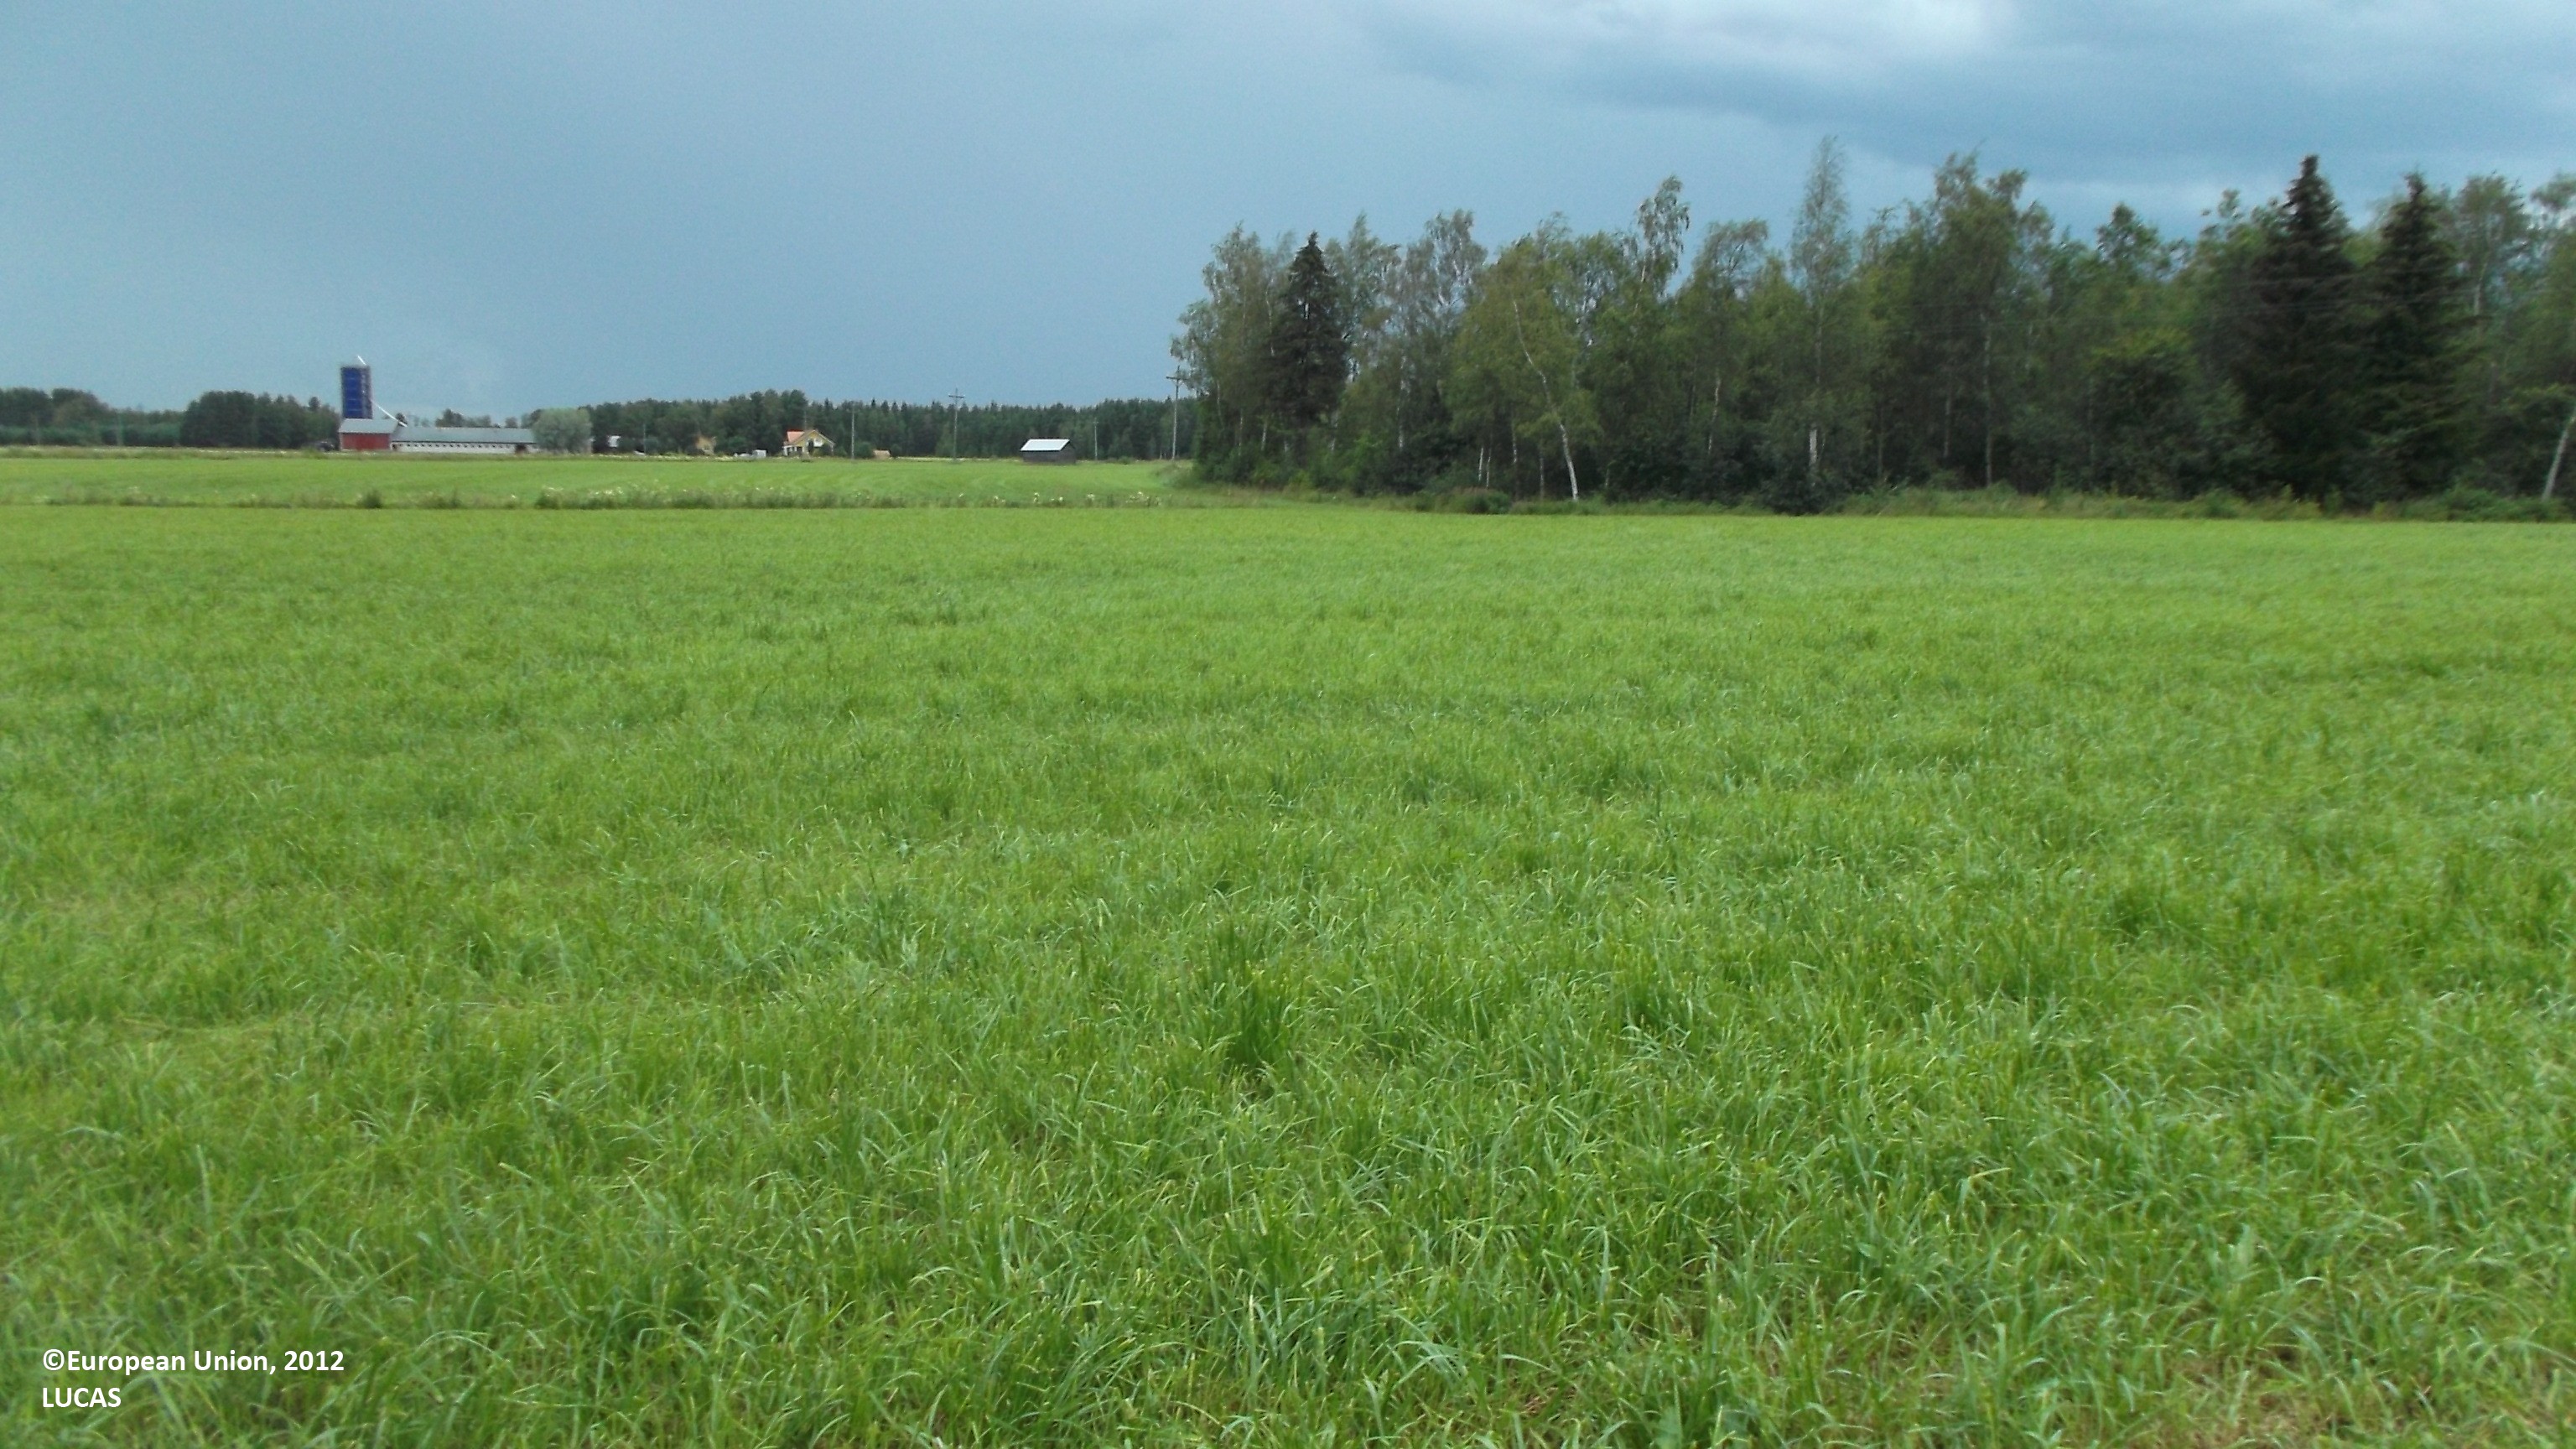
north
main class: Cropland
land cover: Temporary grasslands
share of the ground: > 75 %
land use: Agriculture (excluding fallow land and kitchen gardens)
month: August
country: FI
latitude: 64.0379
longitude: 23.5079
